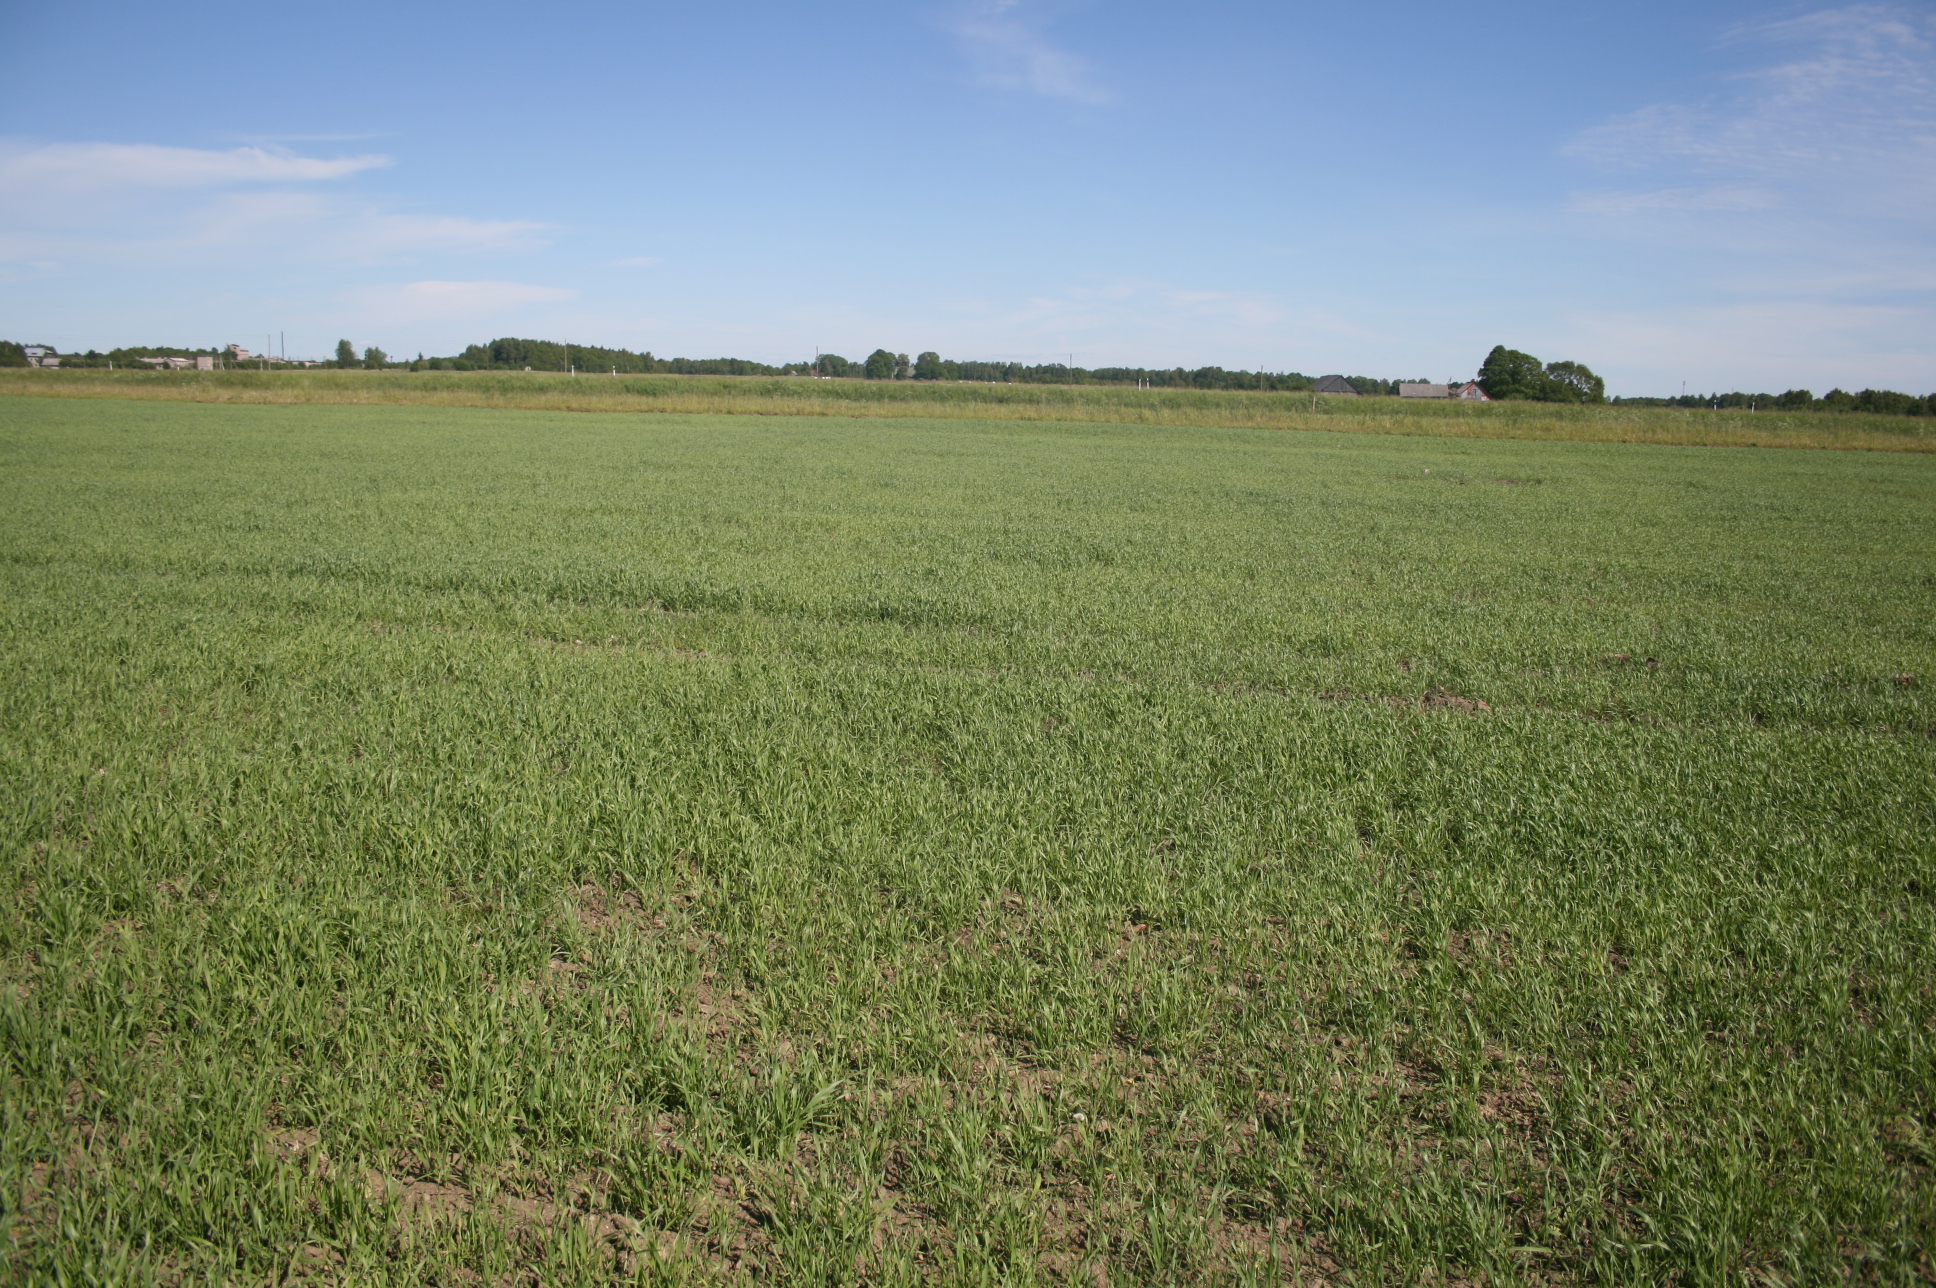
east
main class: Cropland
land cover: Common wheat
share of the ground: > 75 %
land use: Agriculture (excluding fallow land and kitchen gardens)
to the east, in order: Common wheat; Grass margins; Tracks; Grass margins; Dry pulses; Grassland without tree/shrub cover; Paved roads, cycling and walking lanes; Grassland without tree/shrub cover
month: June
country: LT
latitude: 55.9451
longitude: 21.4603
